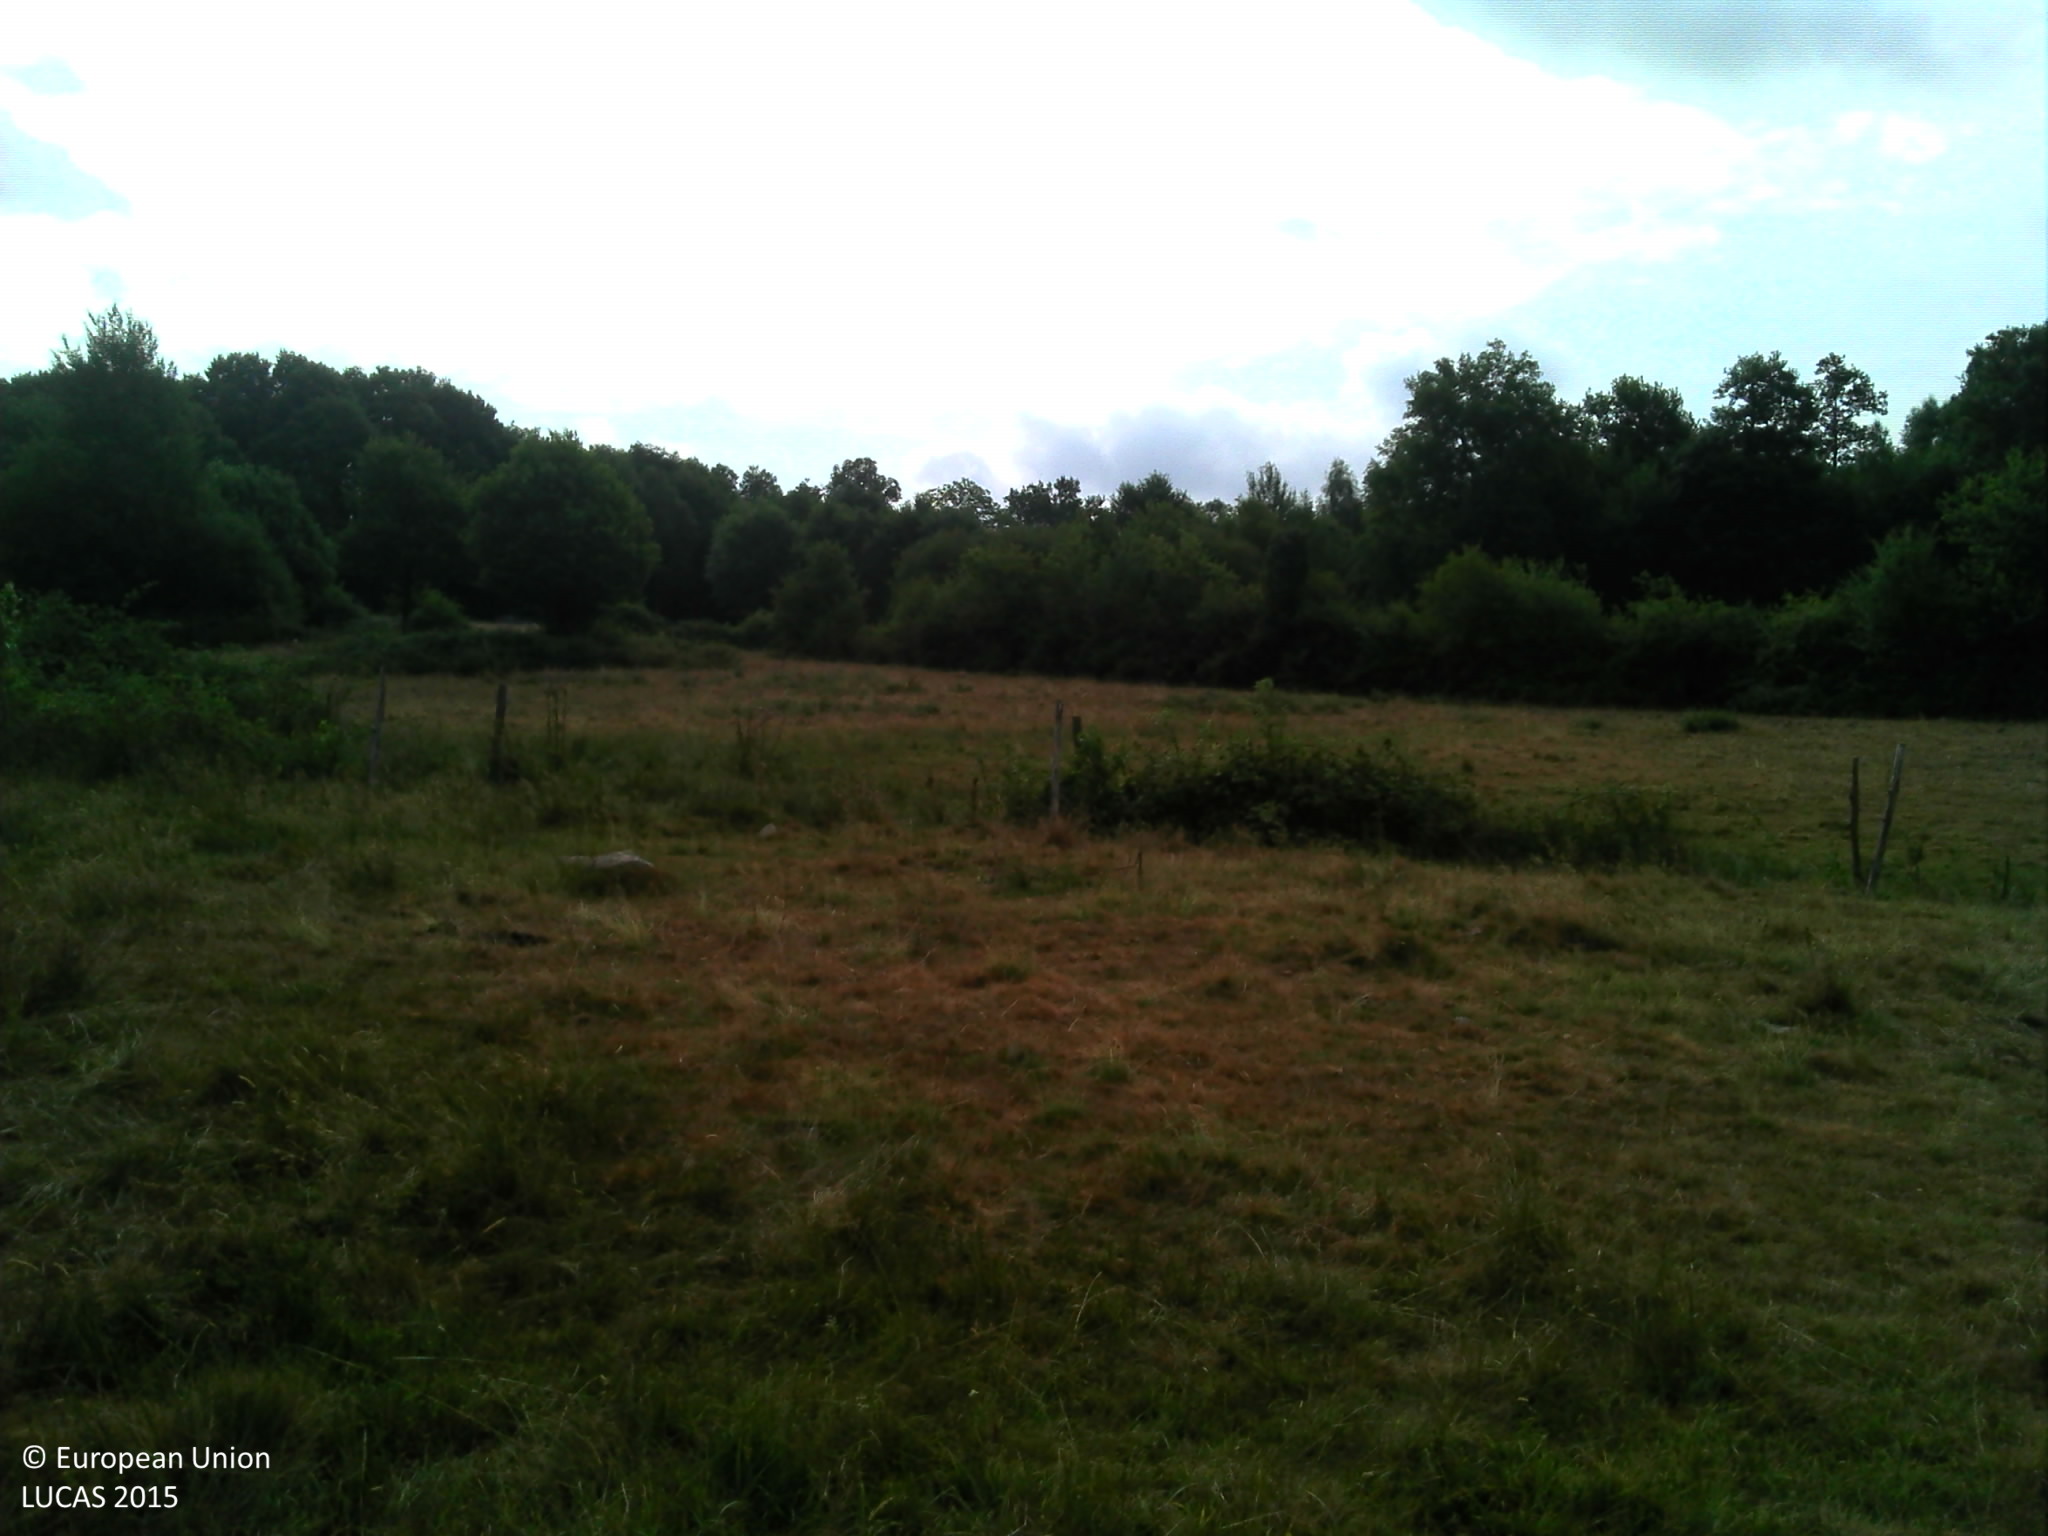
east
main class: Grassland
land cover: Grassland without tree/shrub cover
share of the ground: > 75 %
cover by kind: herbaceous plants 95 %
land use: Agriculture (excluding fallow land and kitchen gardens)
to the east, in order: Grassland without tree/shrub cover; Rivers and streams; Abandoned hedges; Grassland without tree/shrub cover; Fences; Grass margins; Single bushes/trees; Grass margins; Fences; Grassland without tree/shrub cover; Fences; Managed hedges; Common wheat; Tracks; Grass margins; Broadleaved woodland
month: July
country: FR
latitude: 45.8098
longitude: 1.0201
